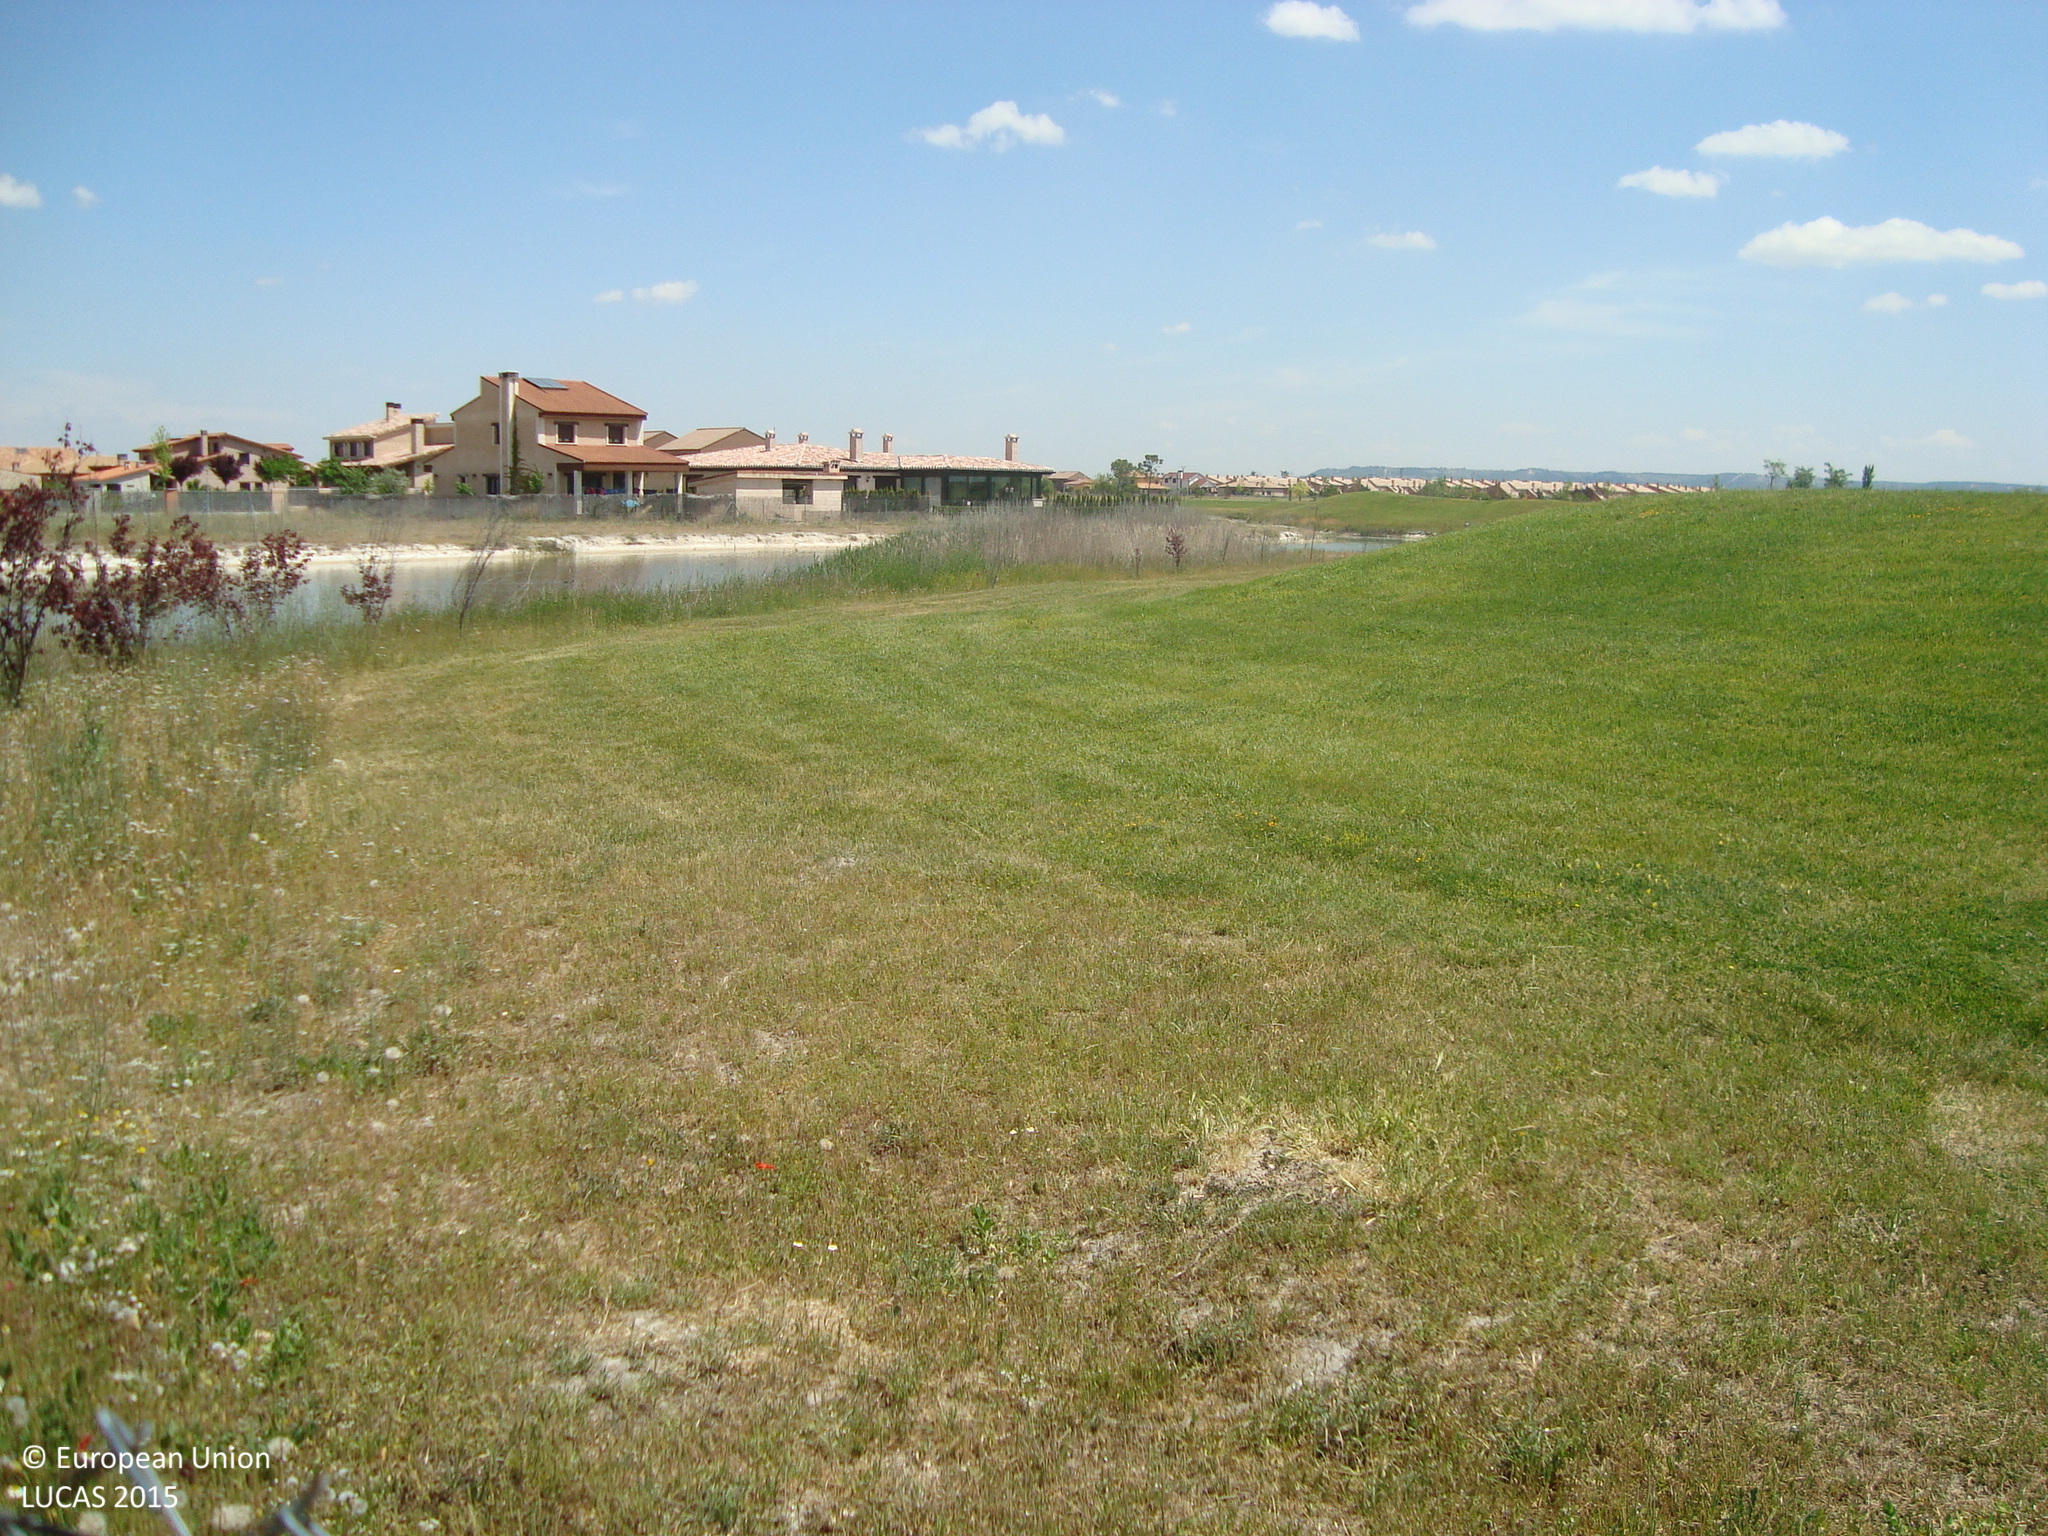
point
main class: Grassland
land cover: Grassland without tree/shrub cover
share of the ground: > 75 %
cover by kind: herbaceous plants 95 %, unconsolidated bare surface 5 %
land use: Sport
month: June
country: ES
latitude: 41.5058
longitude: -4.6706
